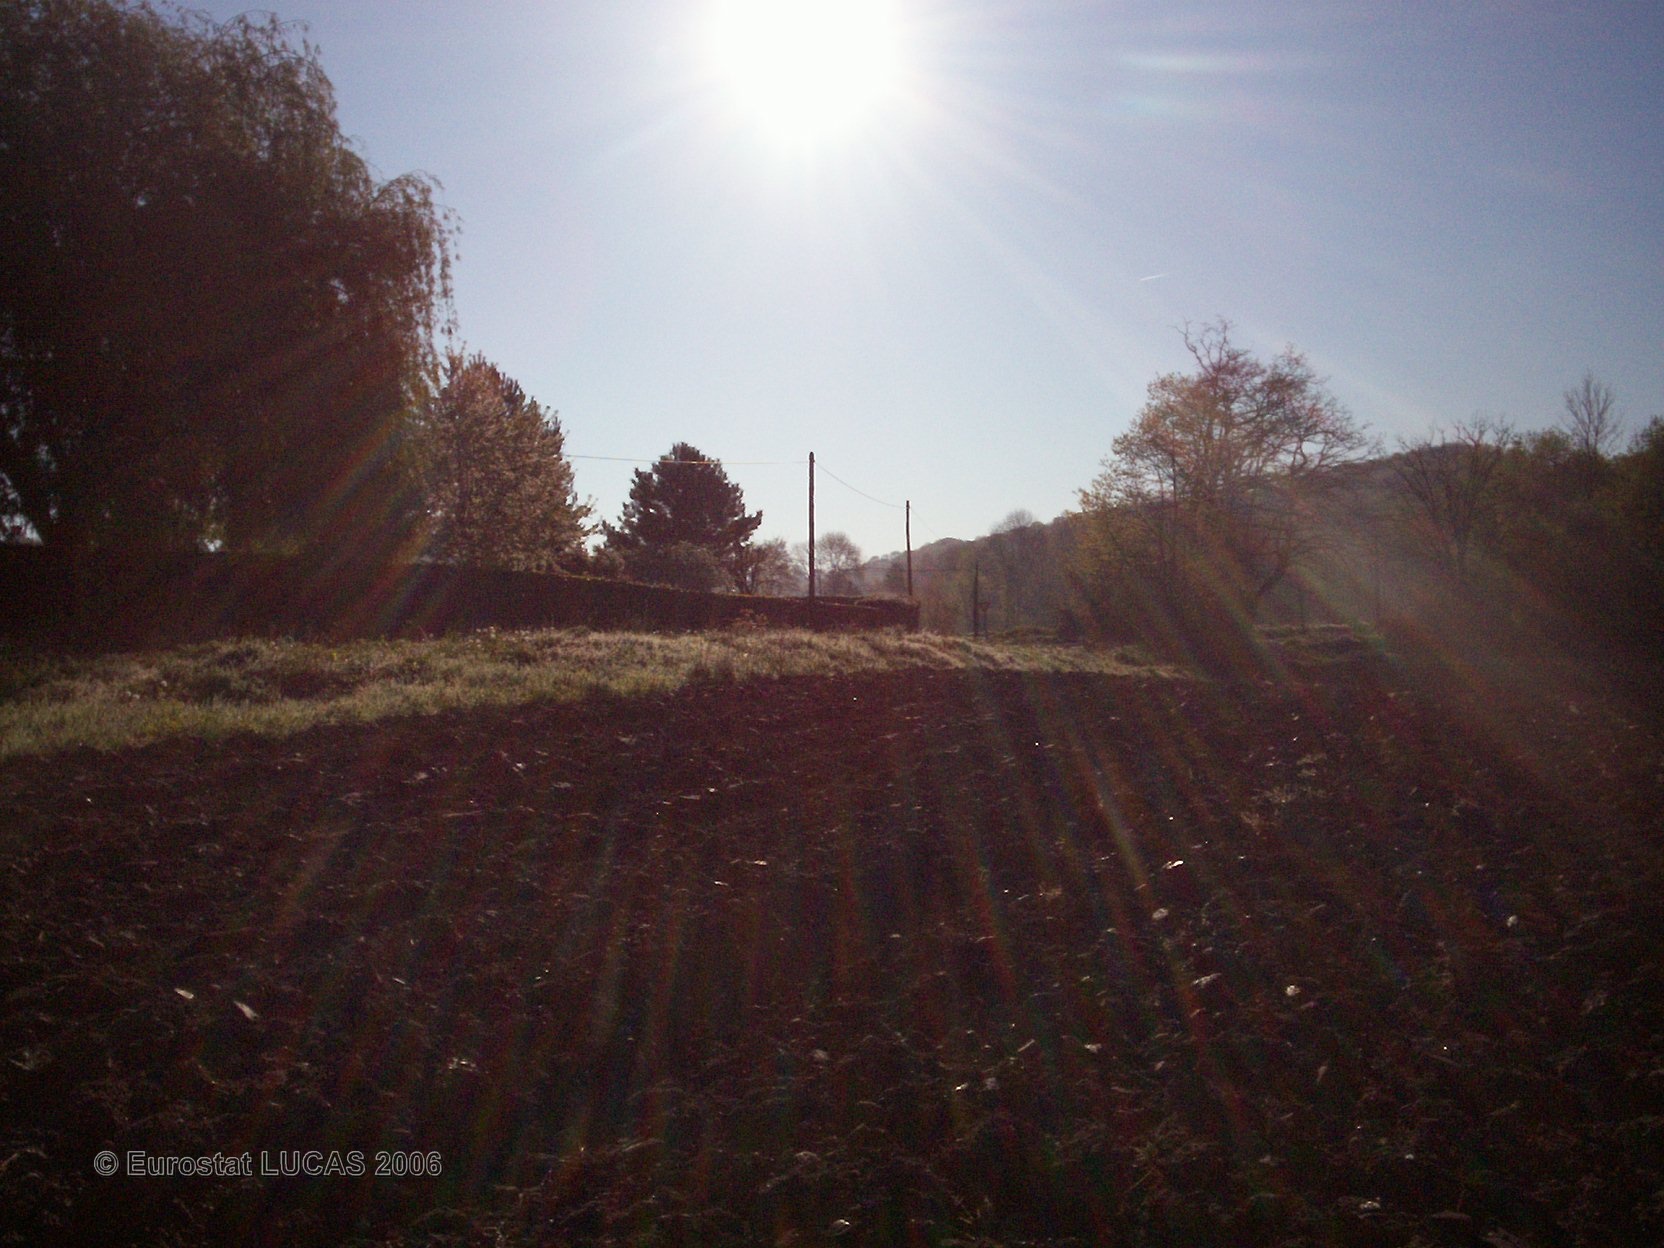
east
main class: Cropland
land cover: Maize
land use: Agriculture (excluding fallow land and kitchen gardens)
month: June
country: FR
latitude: 43.3631
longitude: -0.3103
